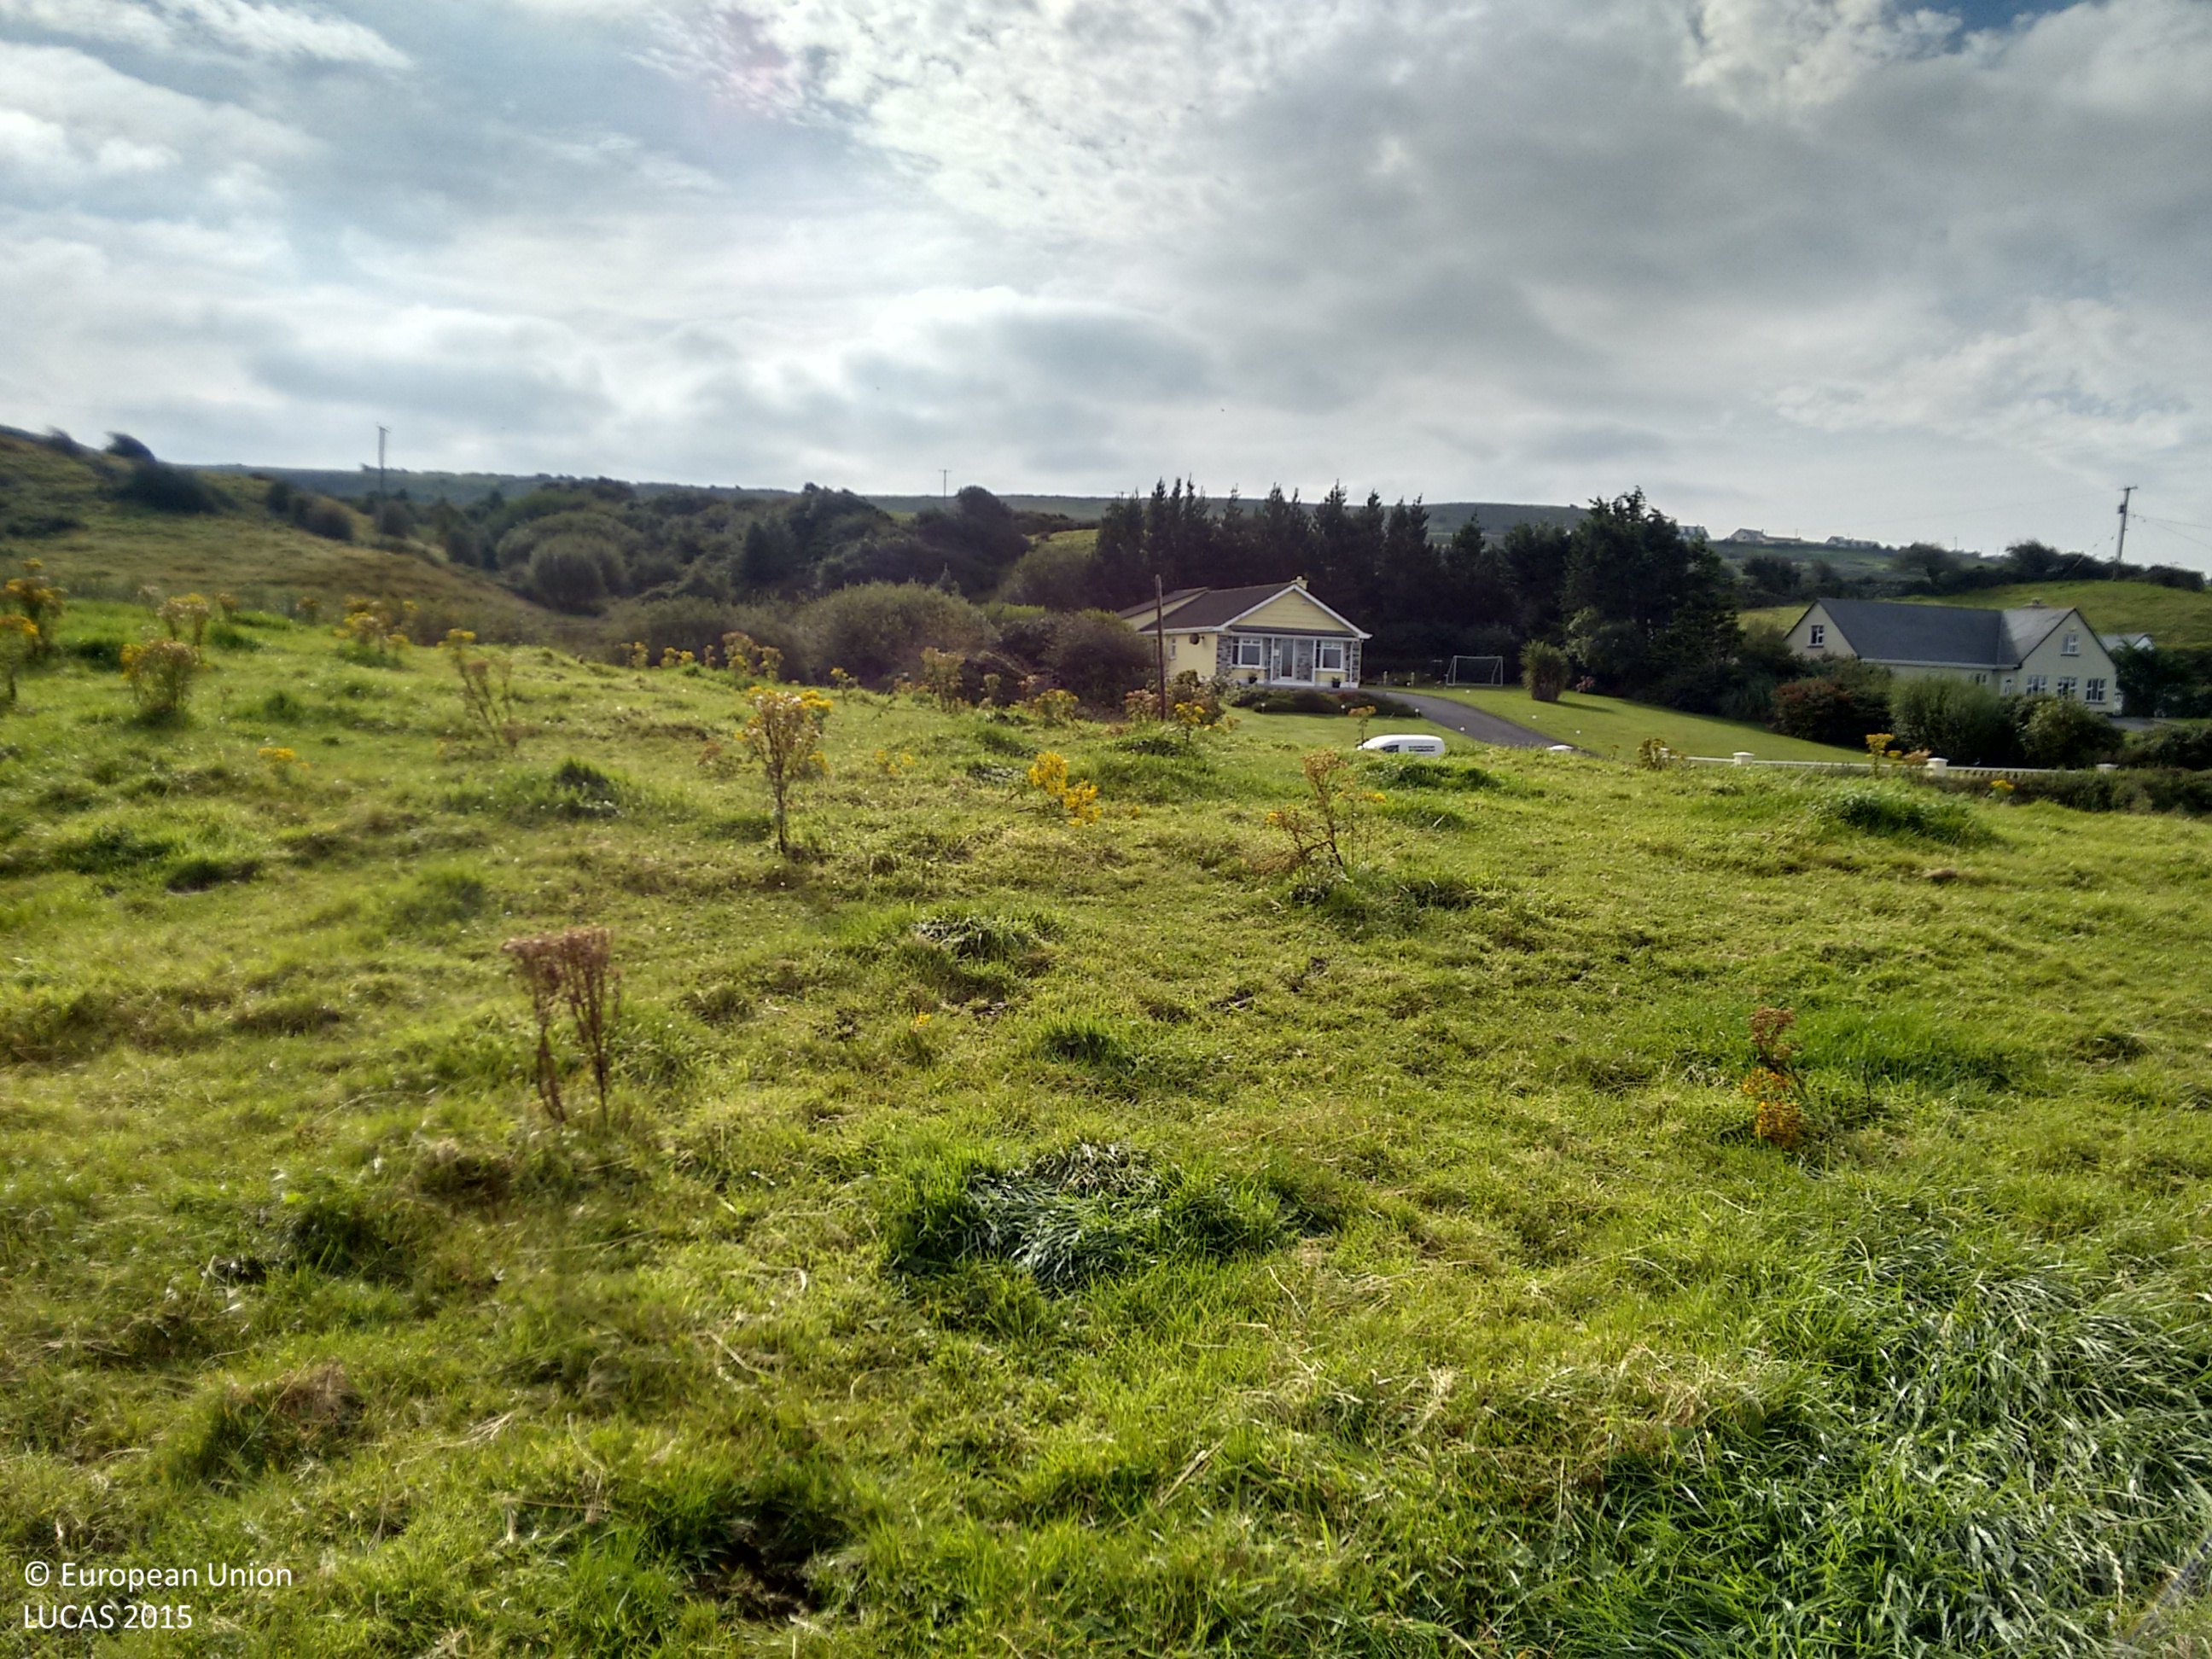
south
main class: Grassland
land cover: Grassland without tree/shrub cover
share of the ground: > 75 %
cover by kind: herbaceous plants 100 %
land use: Agriculture (excluding fallow land and kitchen gardens)
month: September
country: IE
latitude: 52.9357
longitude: -9.3145
